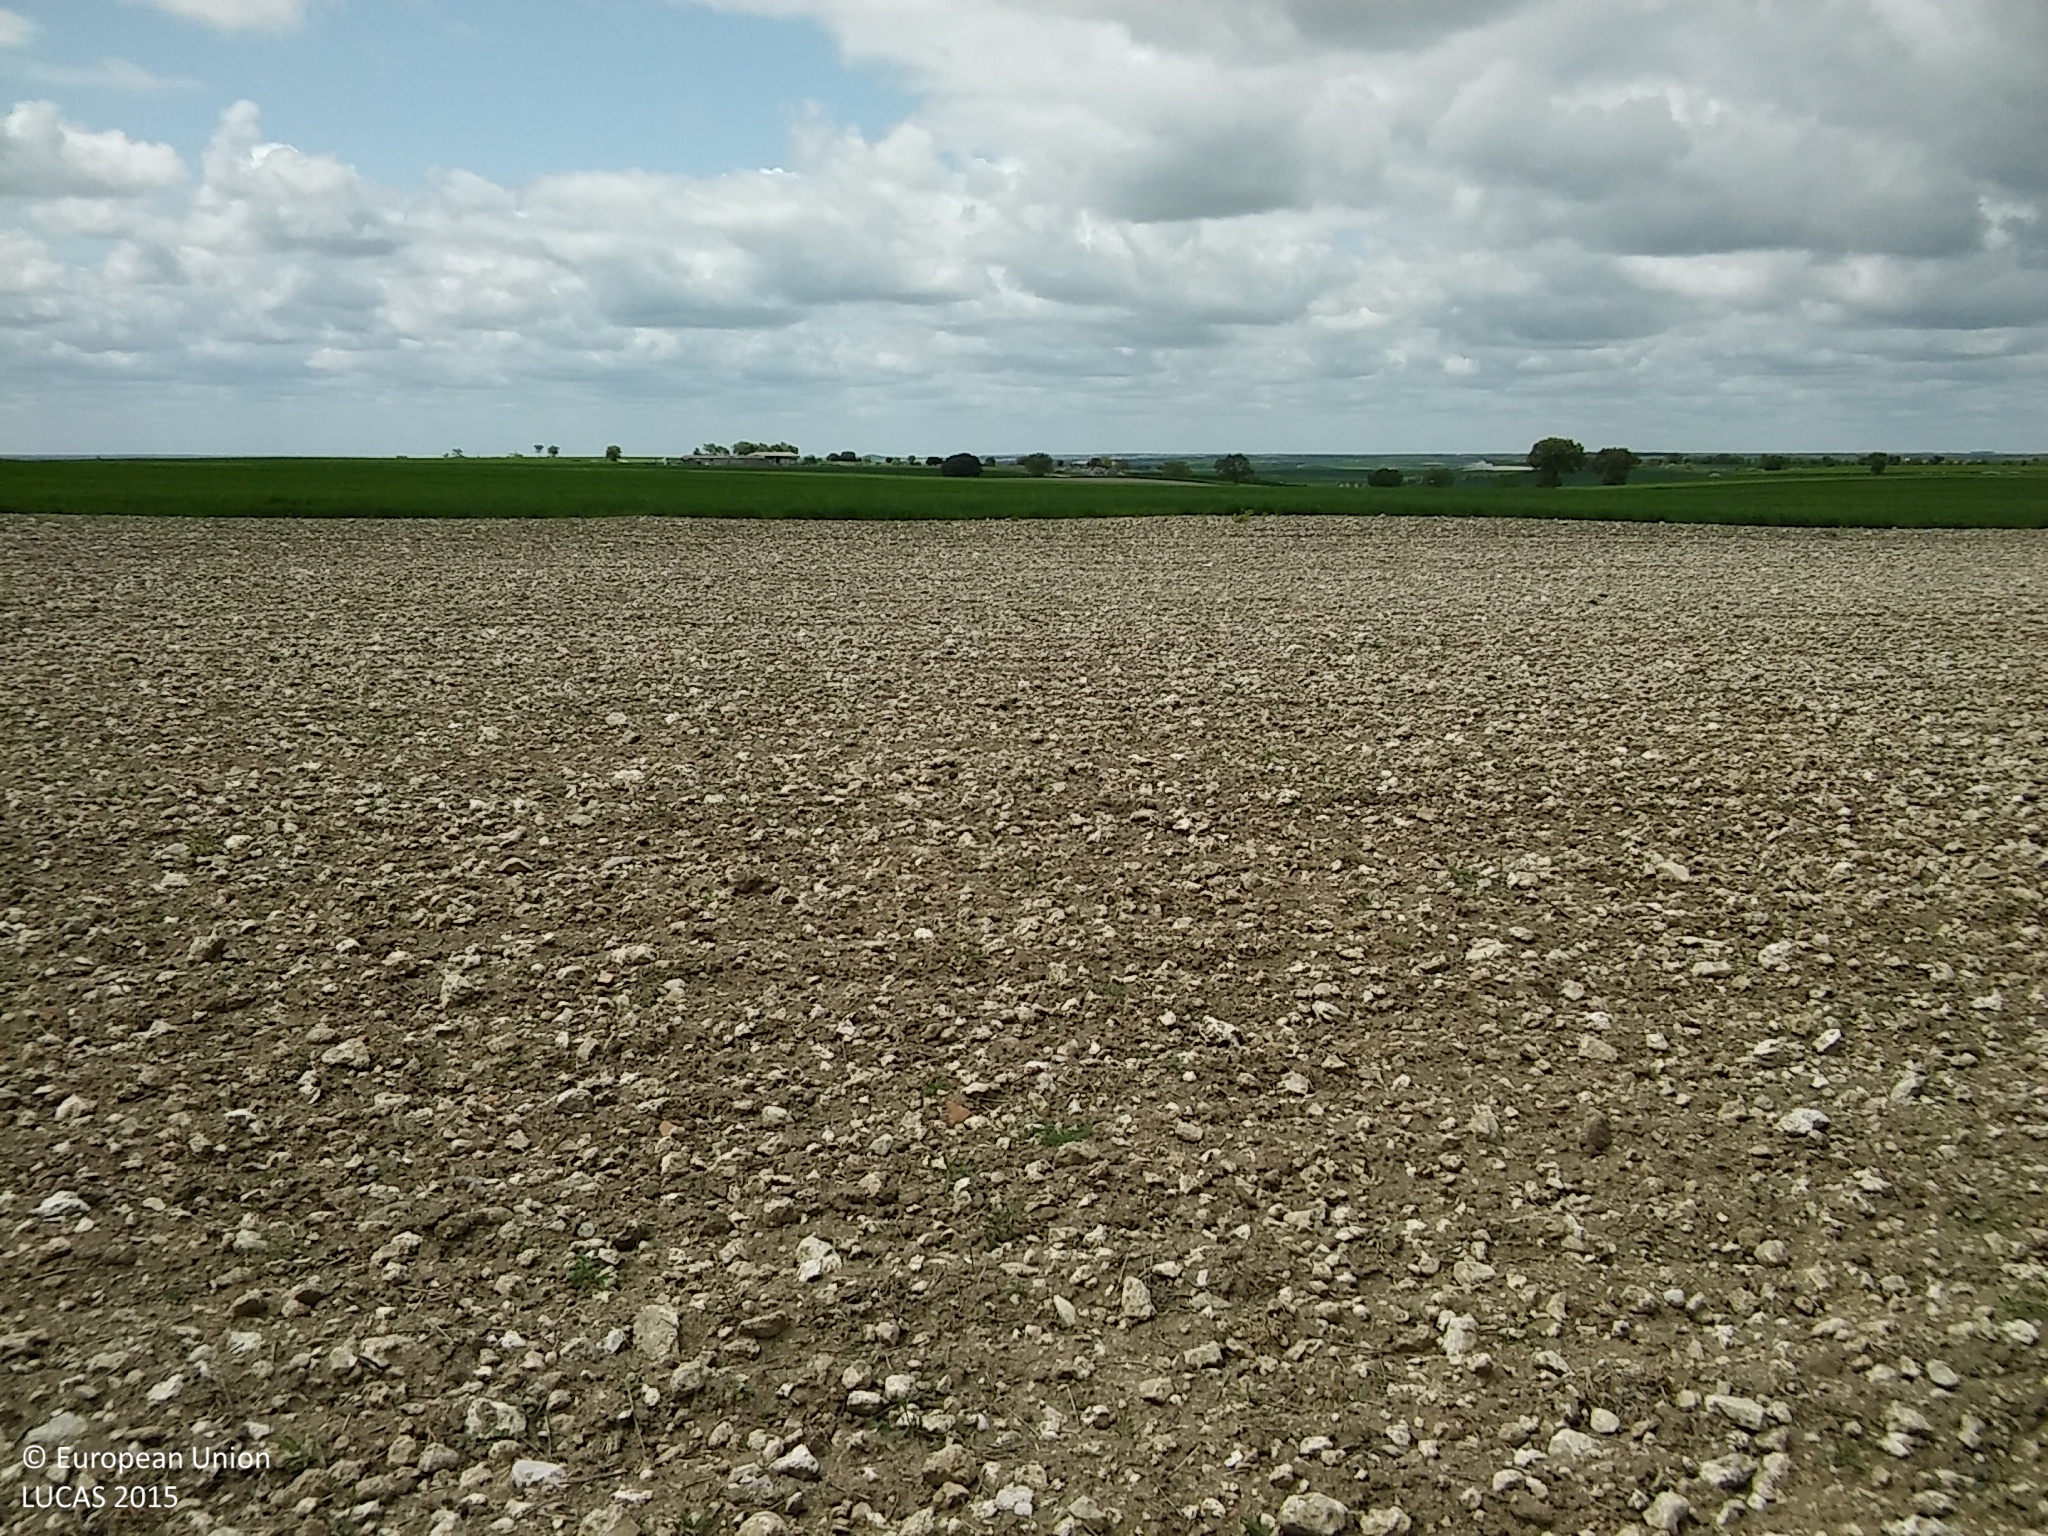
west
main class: Cropland
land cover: Sunflower
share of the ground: < 10 %
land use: Agriculture (excluding fallow land and kitchen gardens)
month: May
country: ES
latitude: 41.4320
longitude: -4.0446
